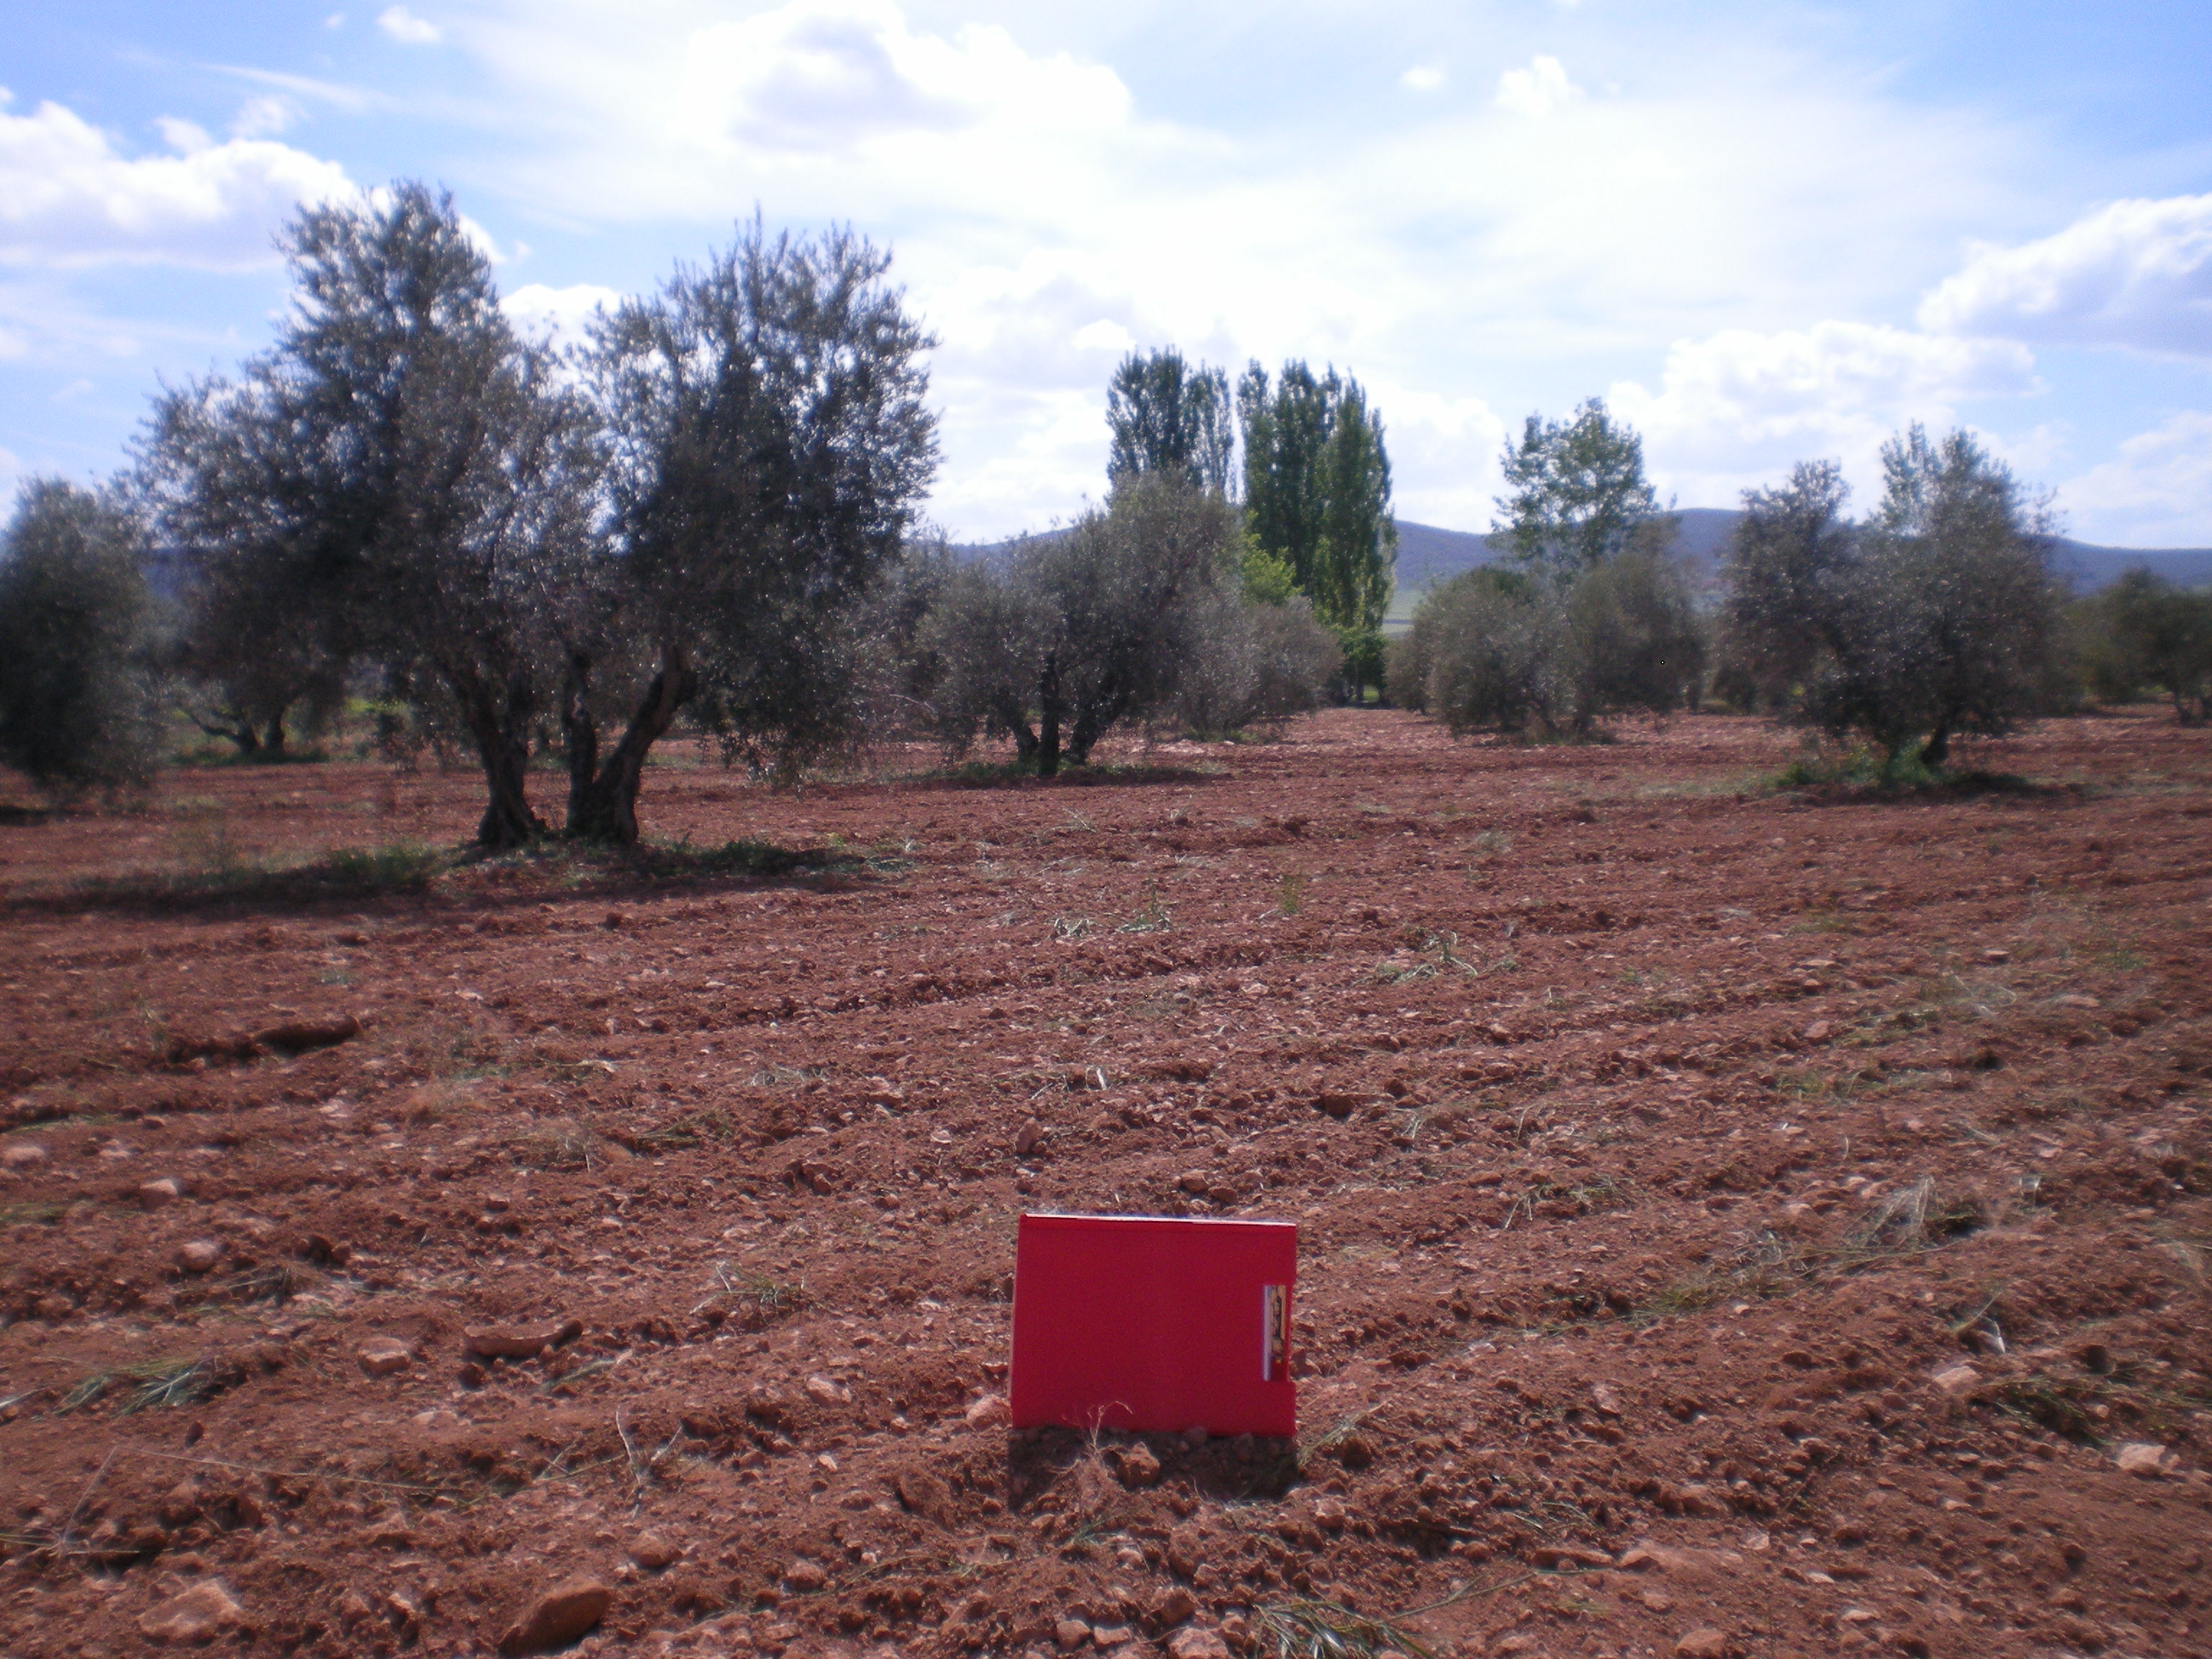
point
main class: Cropland
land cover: Olive groves
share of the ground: 10 - 25 %
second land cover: Other bare soil
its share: > 75 %
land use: Agriculture (excluding fallow land and kitchen gardens)
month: April
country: ES
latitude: 38.6676
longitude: -3.5154
